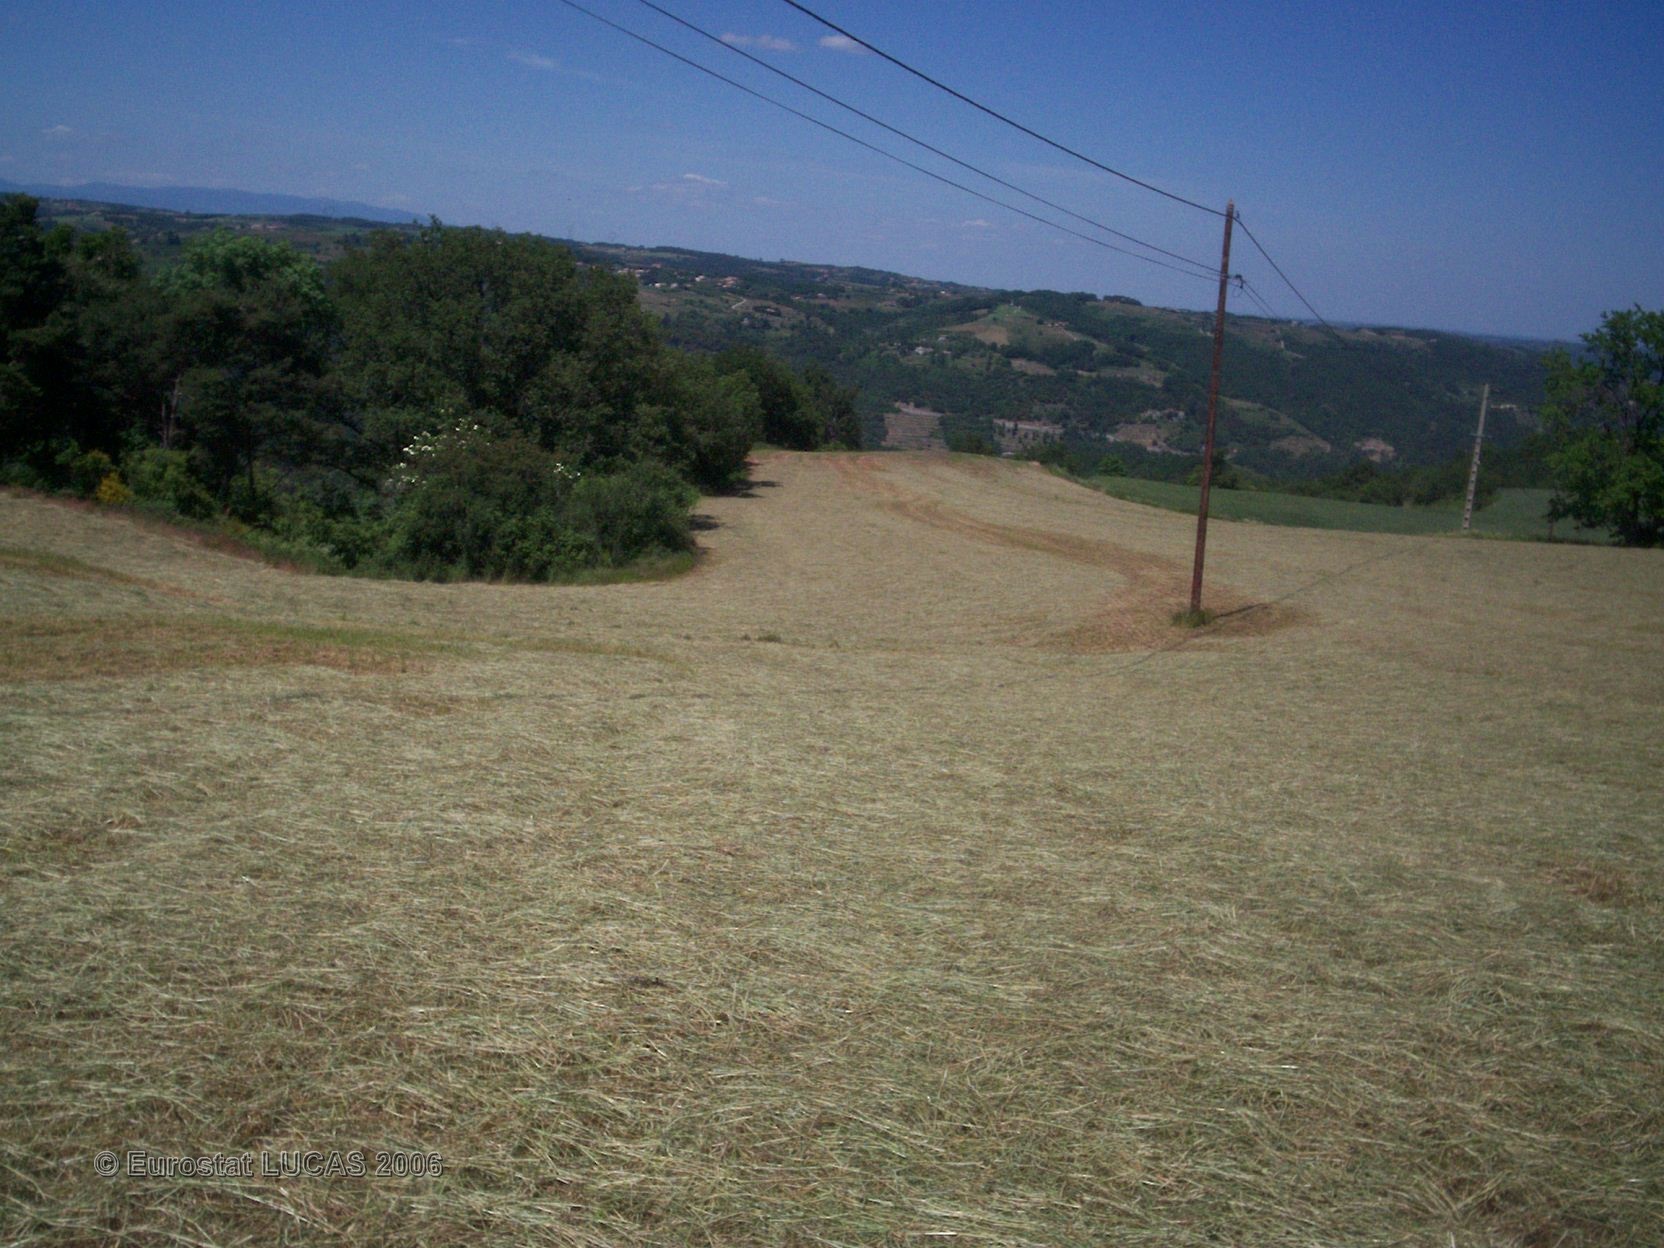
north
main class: Cropland
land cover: Durum wheat
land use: Agriculture (excluding fallow land and kitchen gardens)
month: May
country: FR
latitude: 45.0506
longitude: 4.7868
